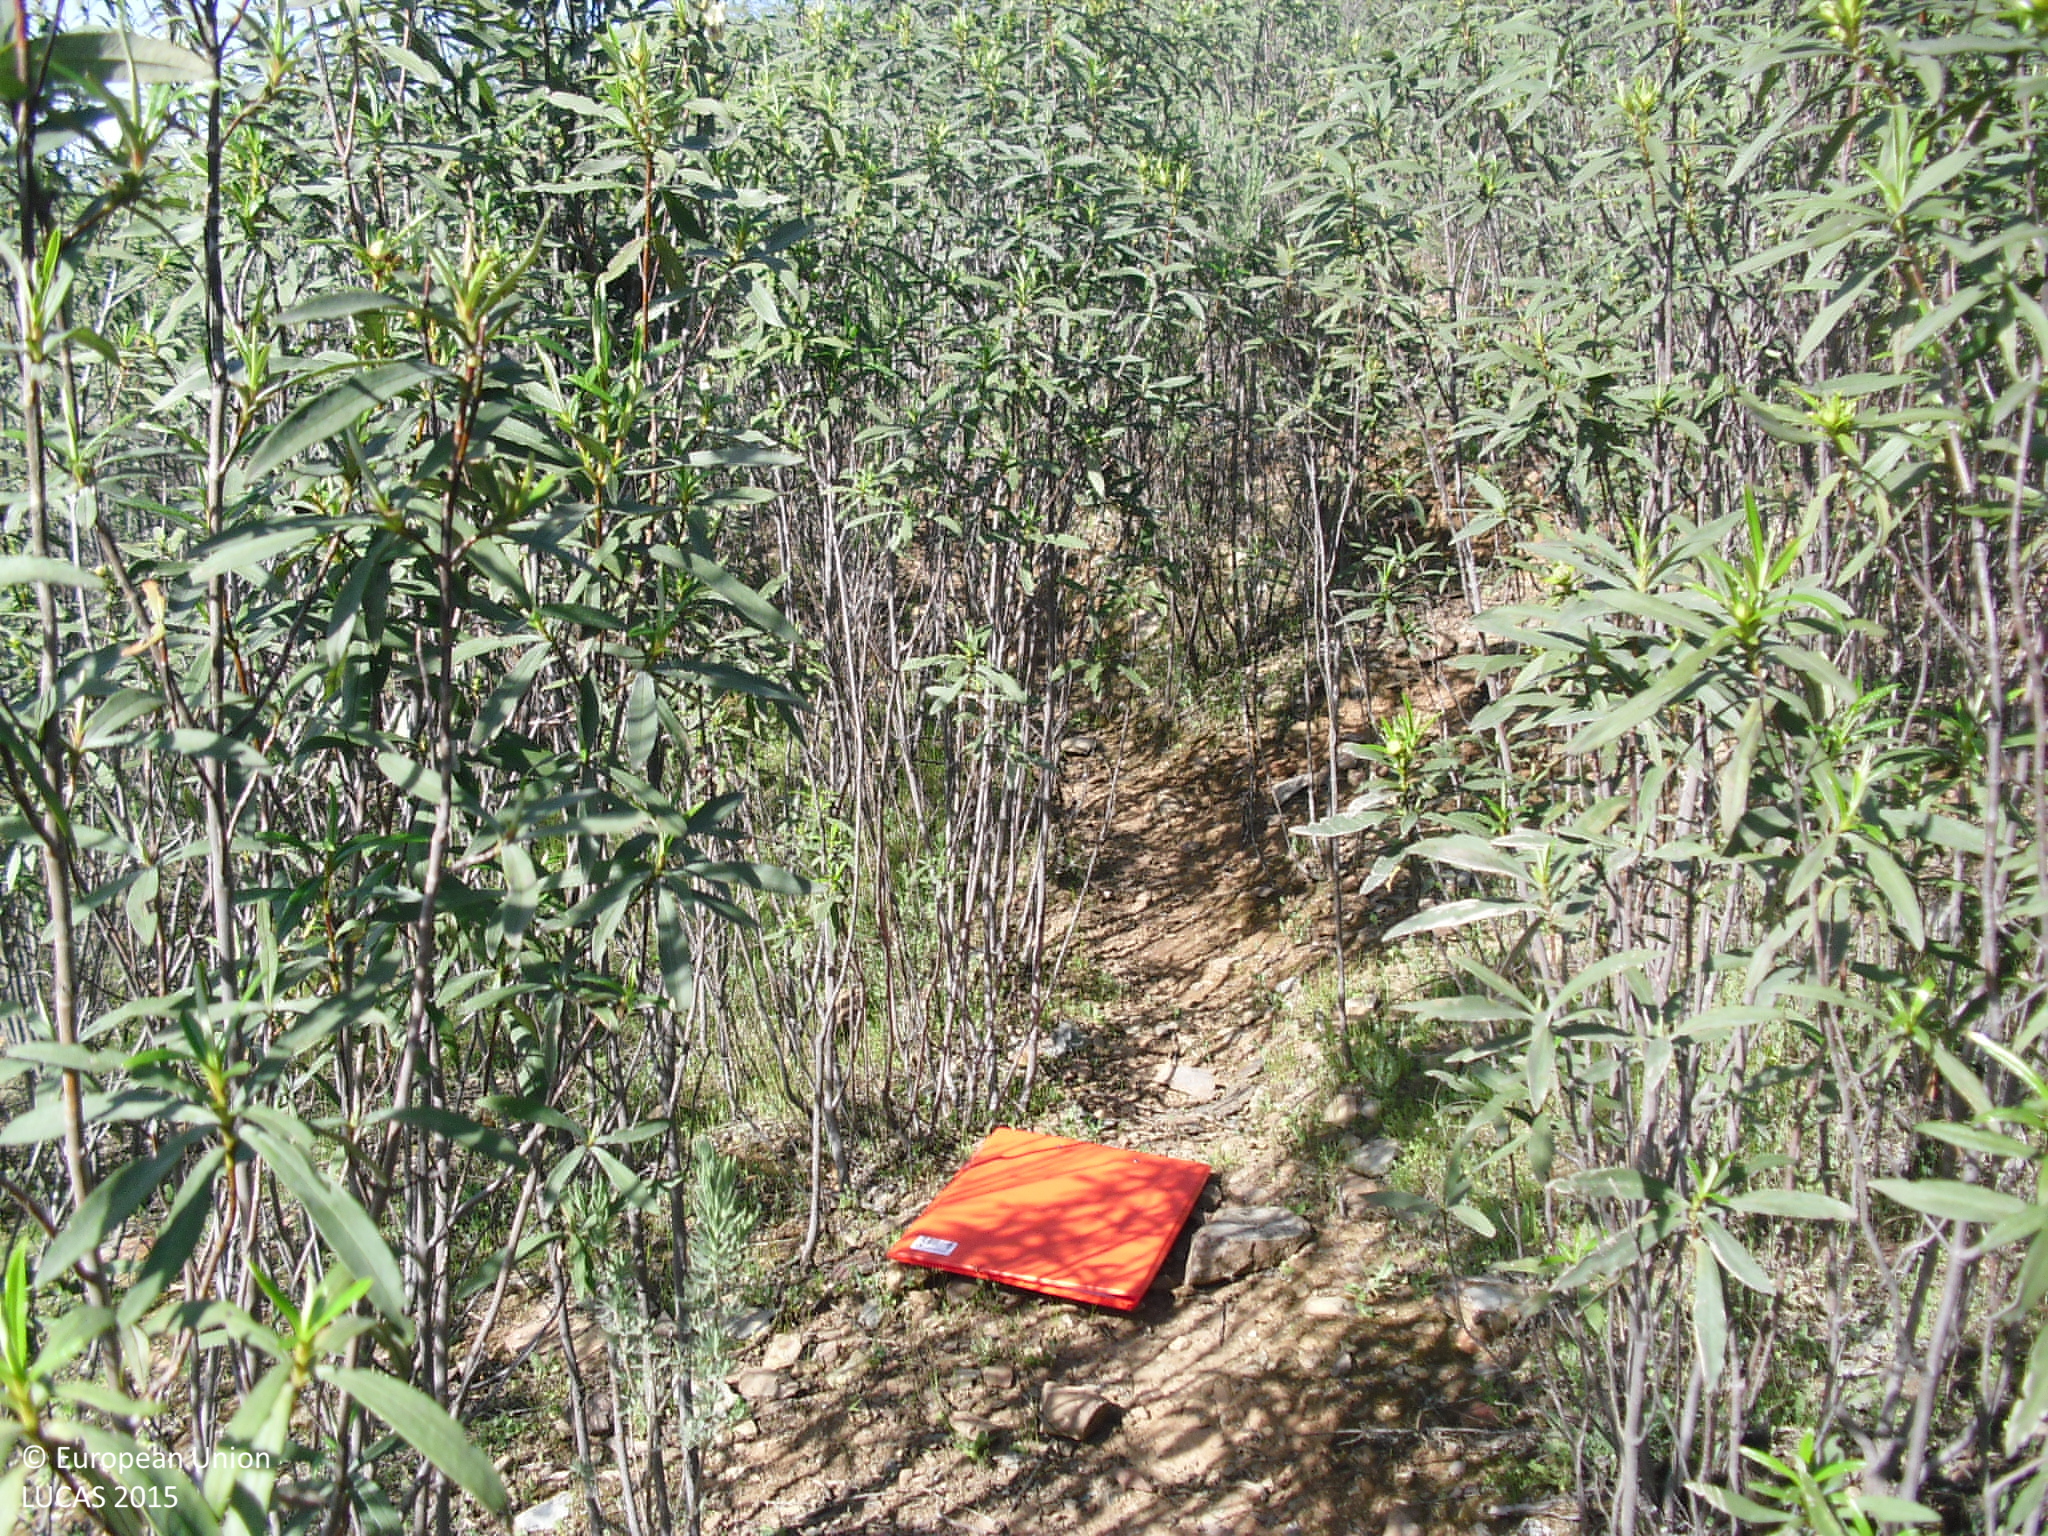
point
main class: Shrubland
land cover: Shrubland without tree cover
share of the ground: > 75 %
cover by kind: shrubs 100 %
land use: Semi-natural and natural areas not in use
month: April
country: ES
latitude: 39.3878
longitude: -5.3145
